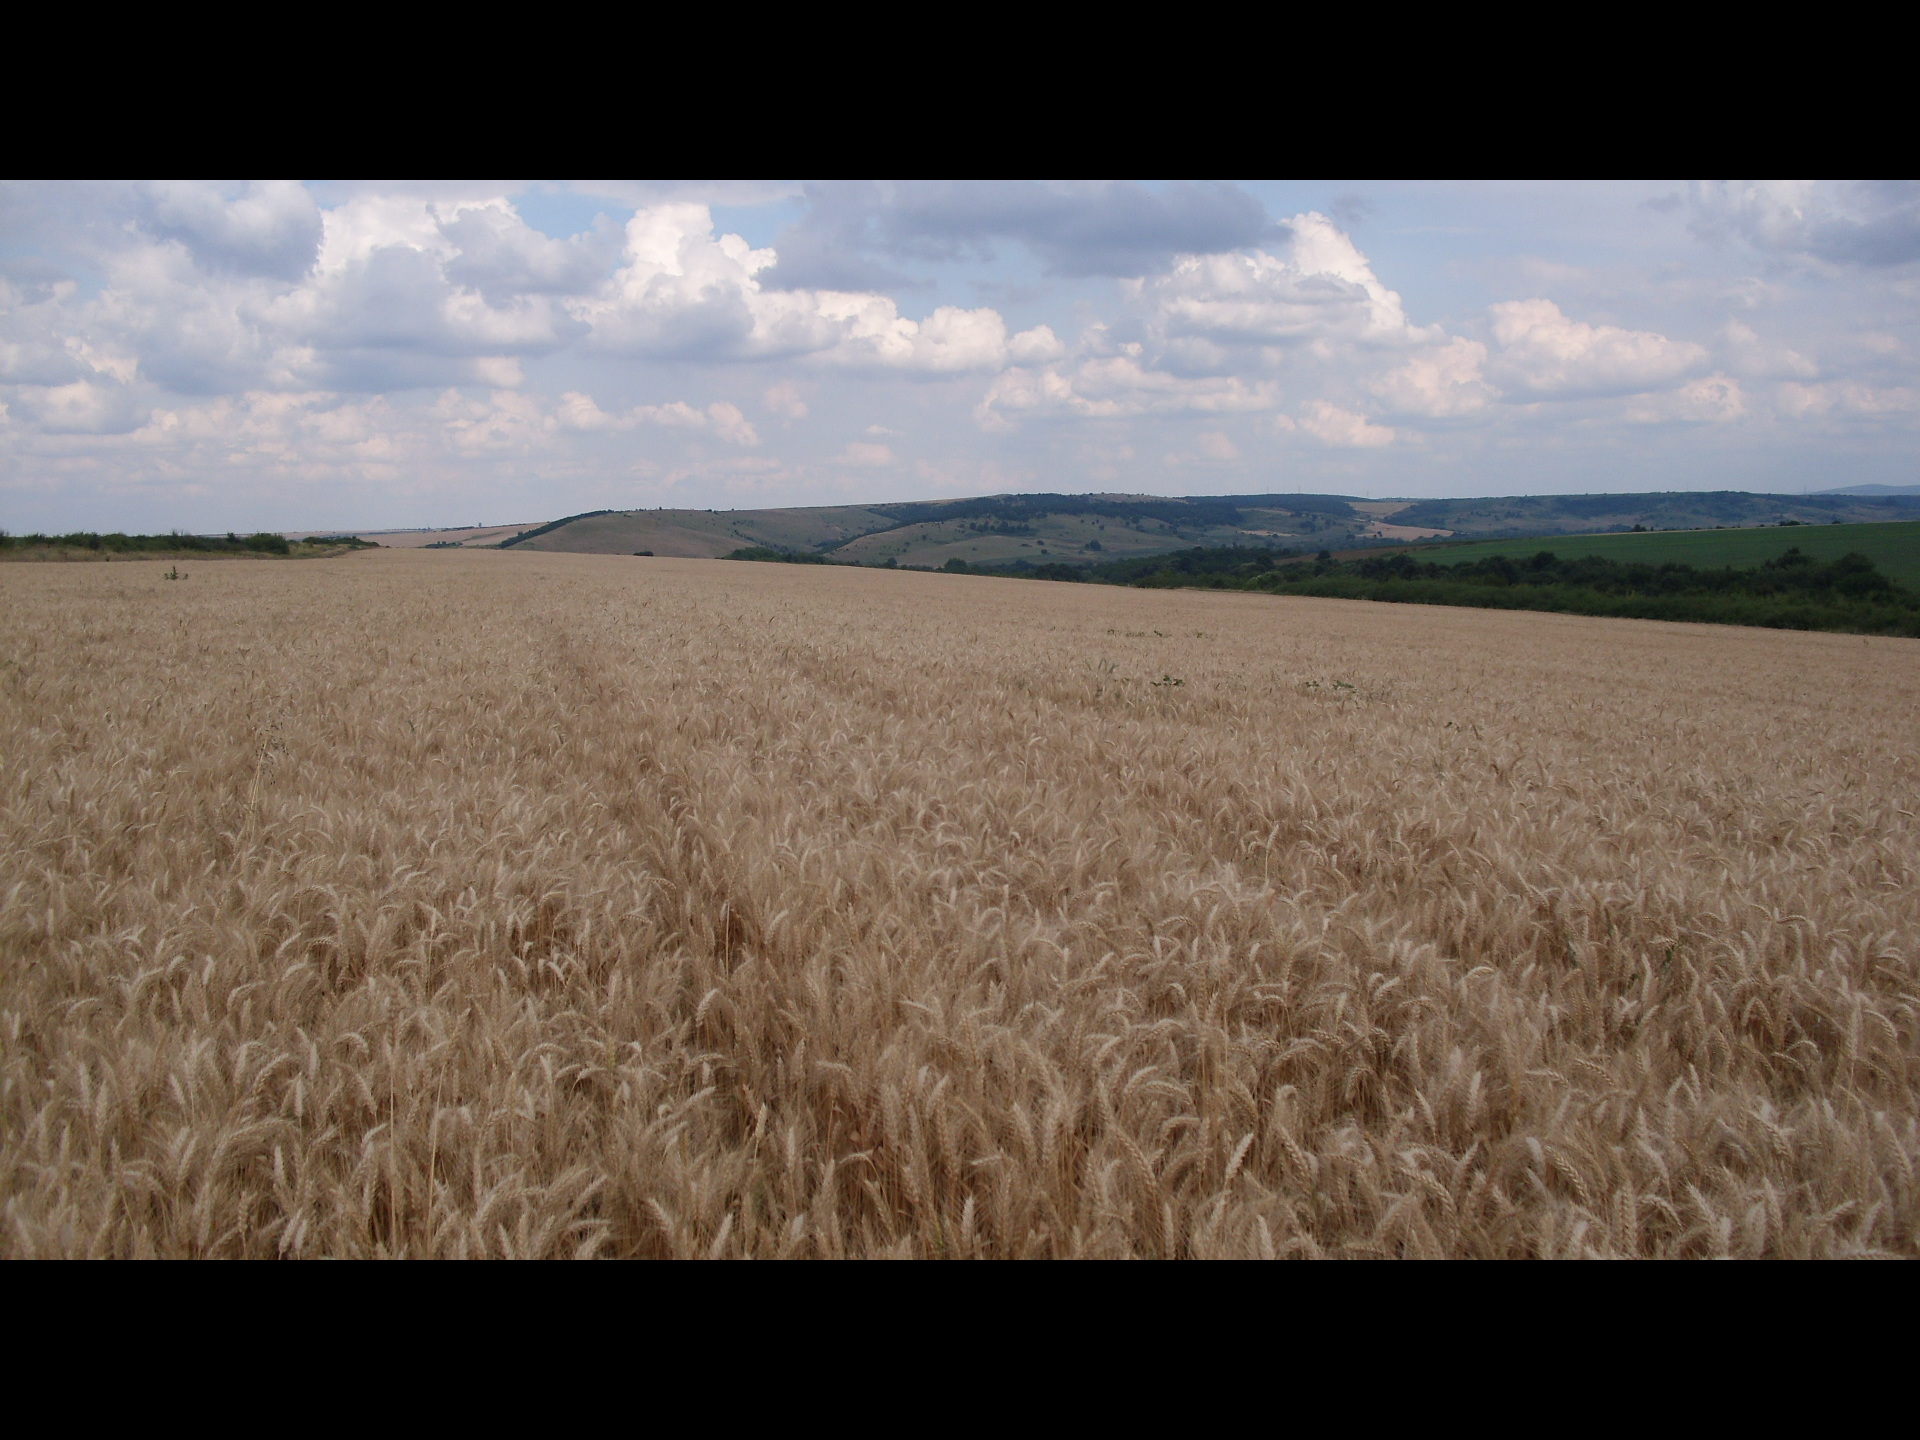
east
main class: Cropland
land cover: Common wheat
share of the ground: > 75 %
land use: Agriculture (excluding fallow land and kitchen gardens)
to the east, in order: Common wheat; Grass margins; Tracks; Grassland with sparse tree/shrub cover; Shrubland without tree cover
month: June
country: BG
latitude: 43.4631
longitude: 23.5044
